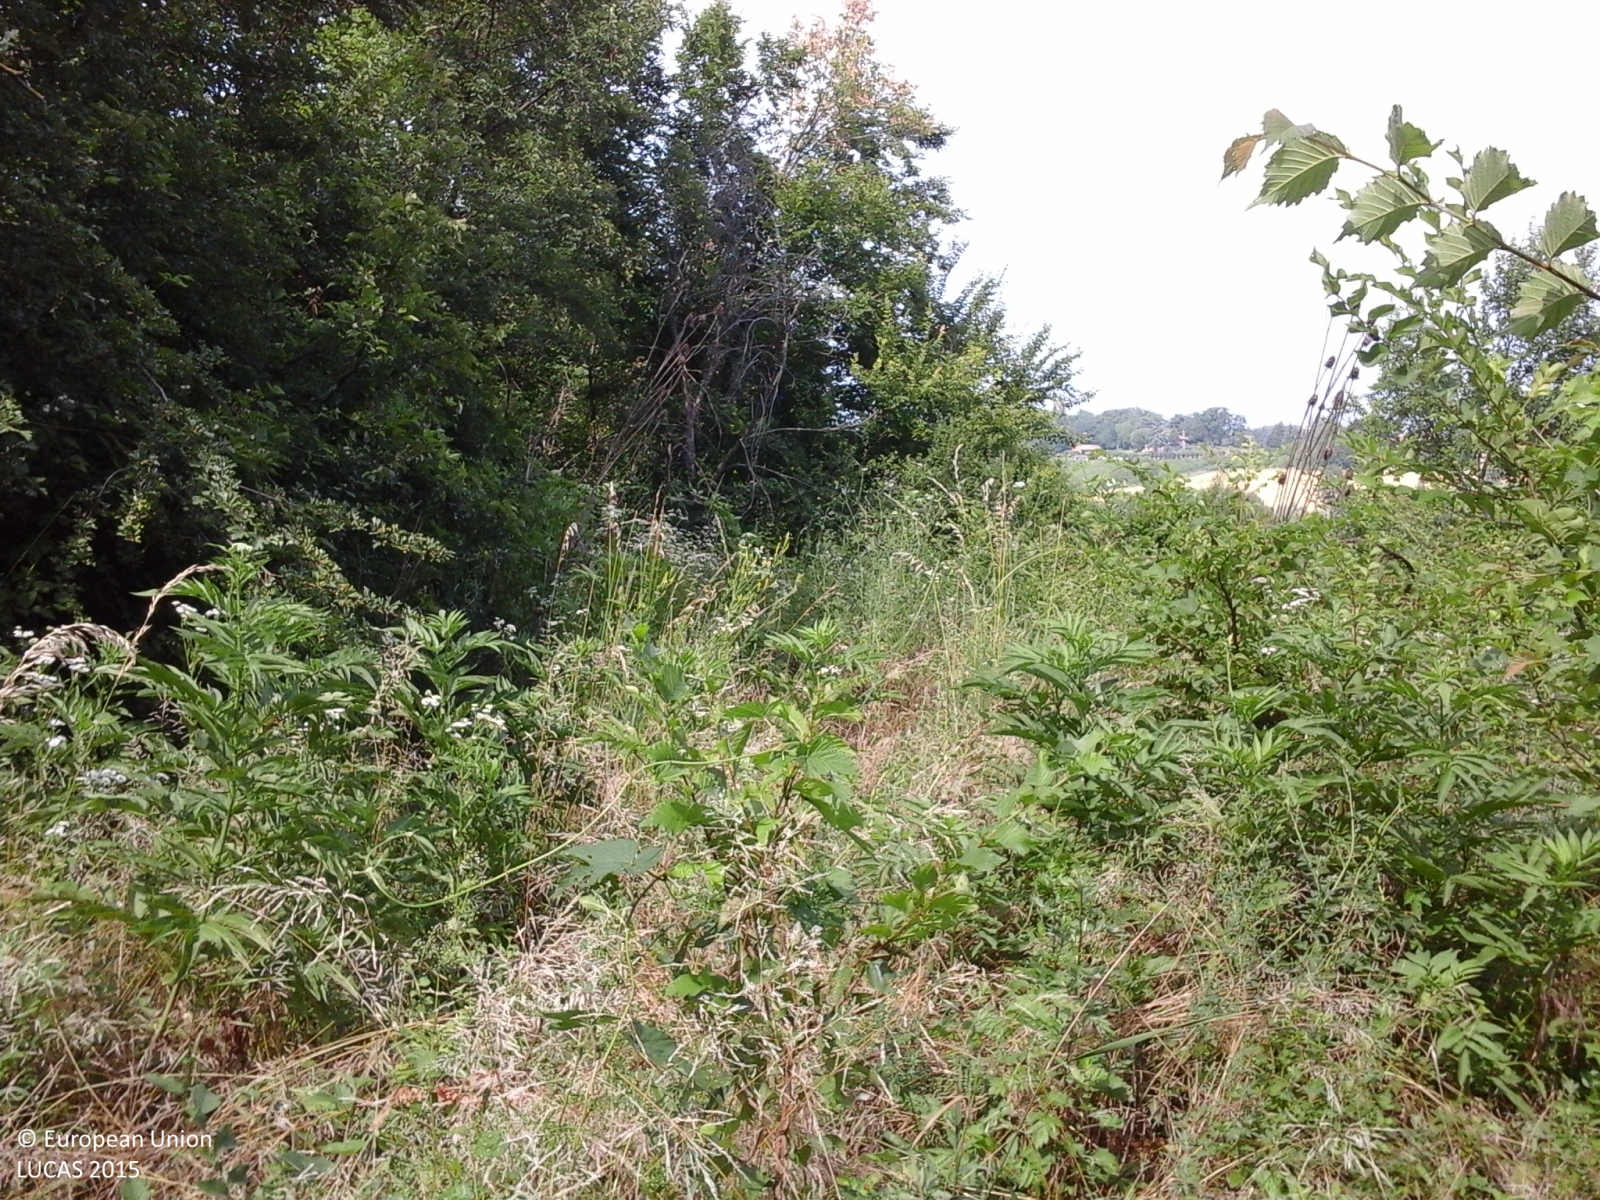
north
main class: Woodland
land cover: Broadleaved woodland
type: thermophilous deciduous forest
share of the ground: > 75 %
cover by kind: broadleaved forest trees 70 %, shrubs 30 %
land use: Forestry
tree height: > 5 m
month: June
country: IT
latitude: 44.8554
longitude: 9.9116
